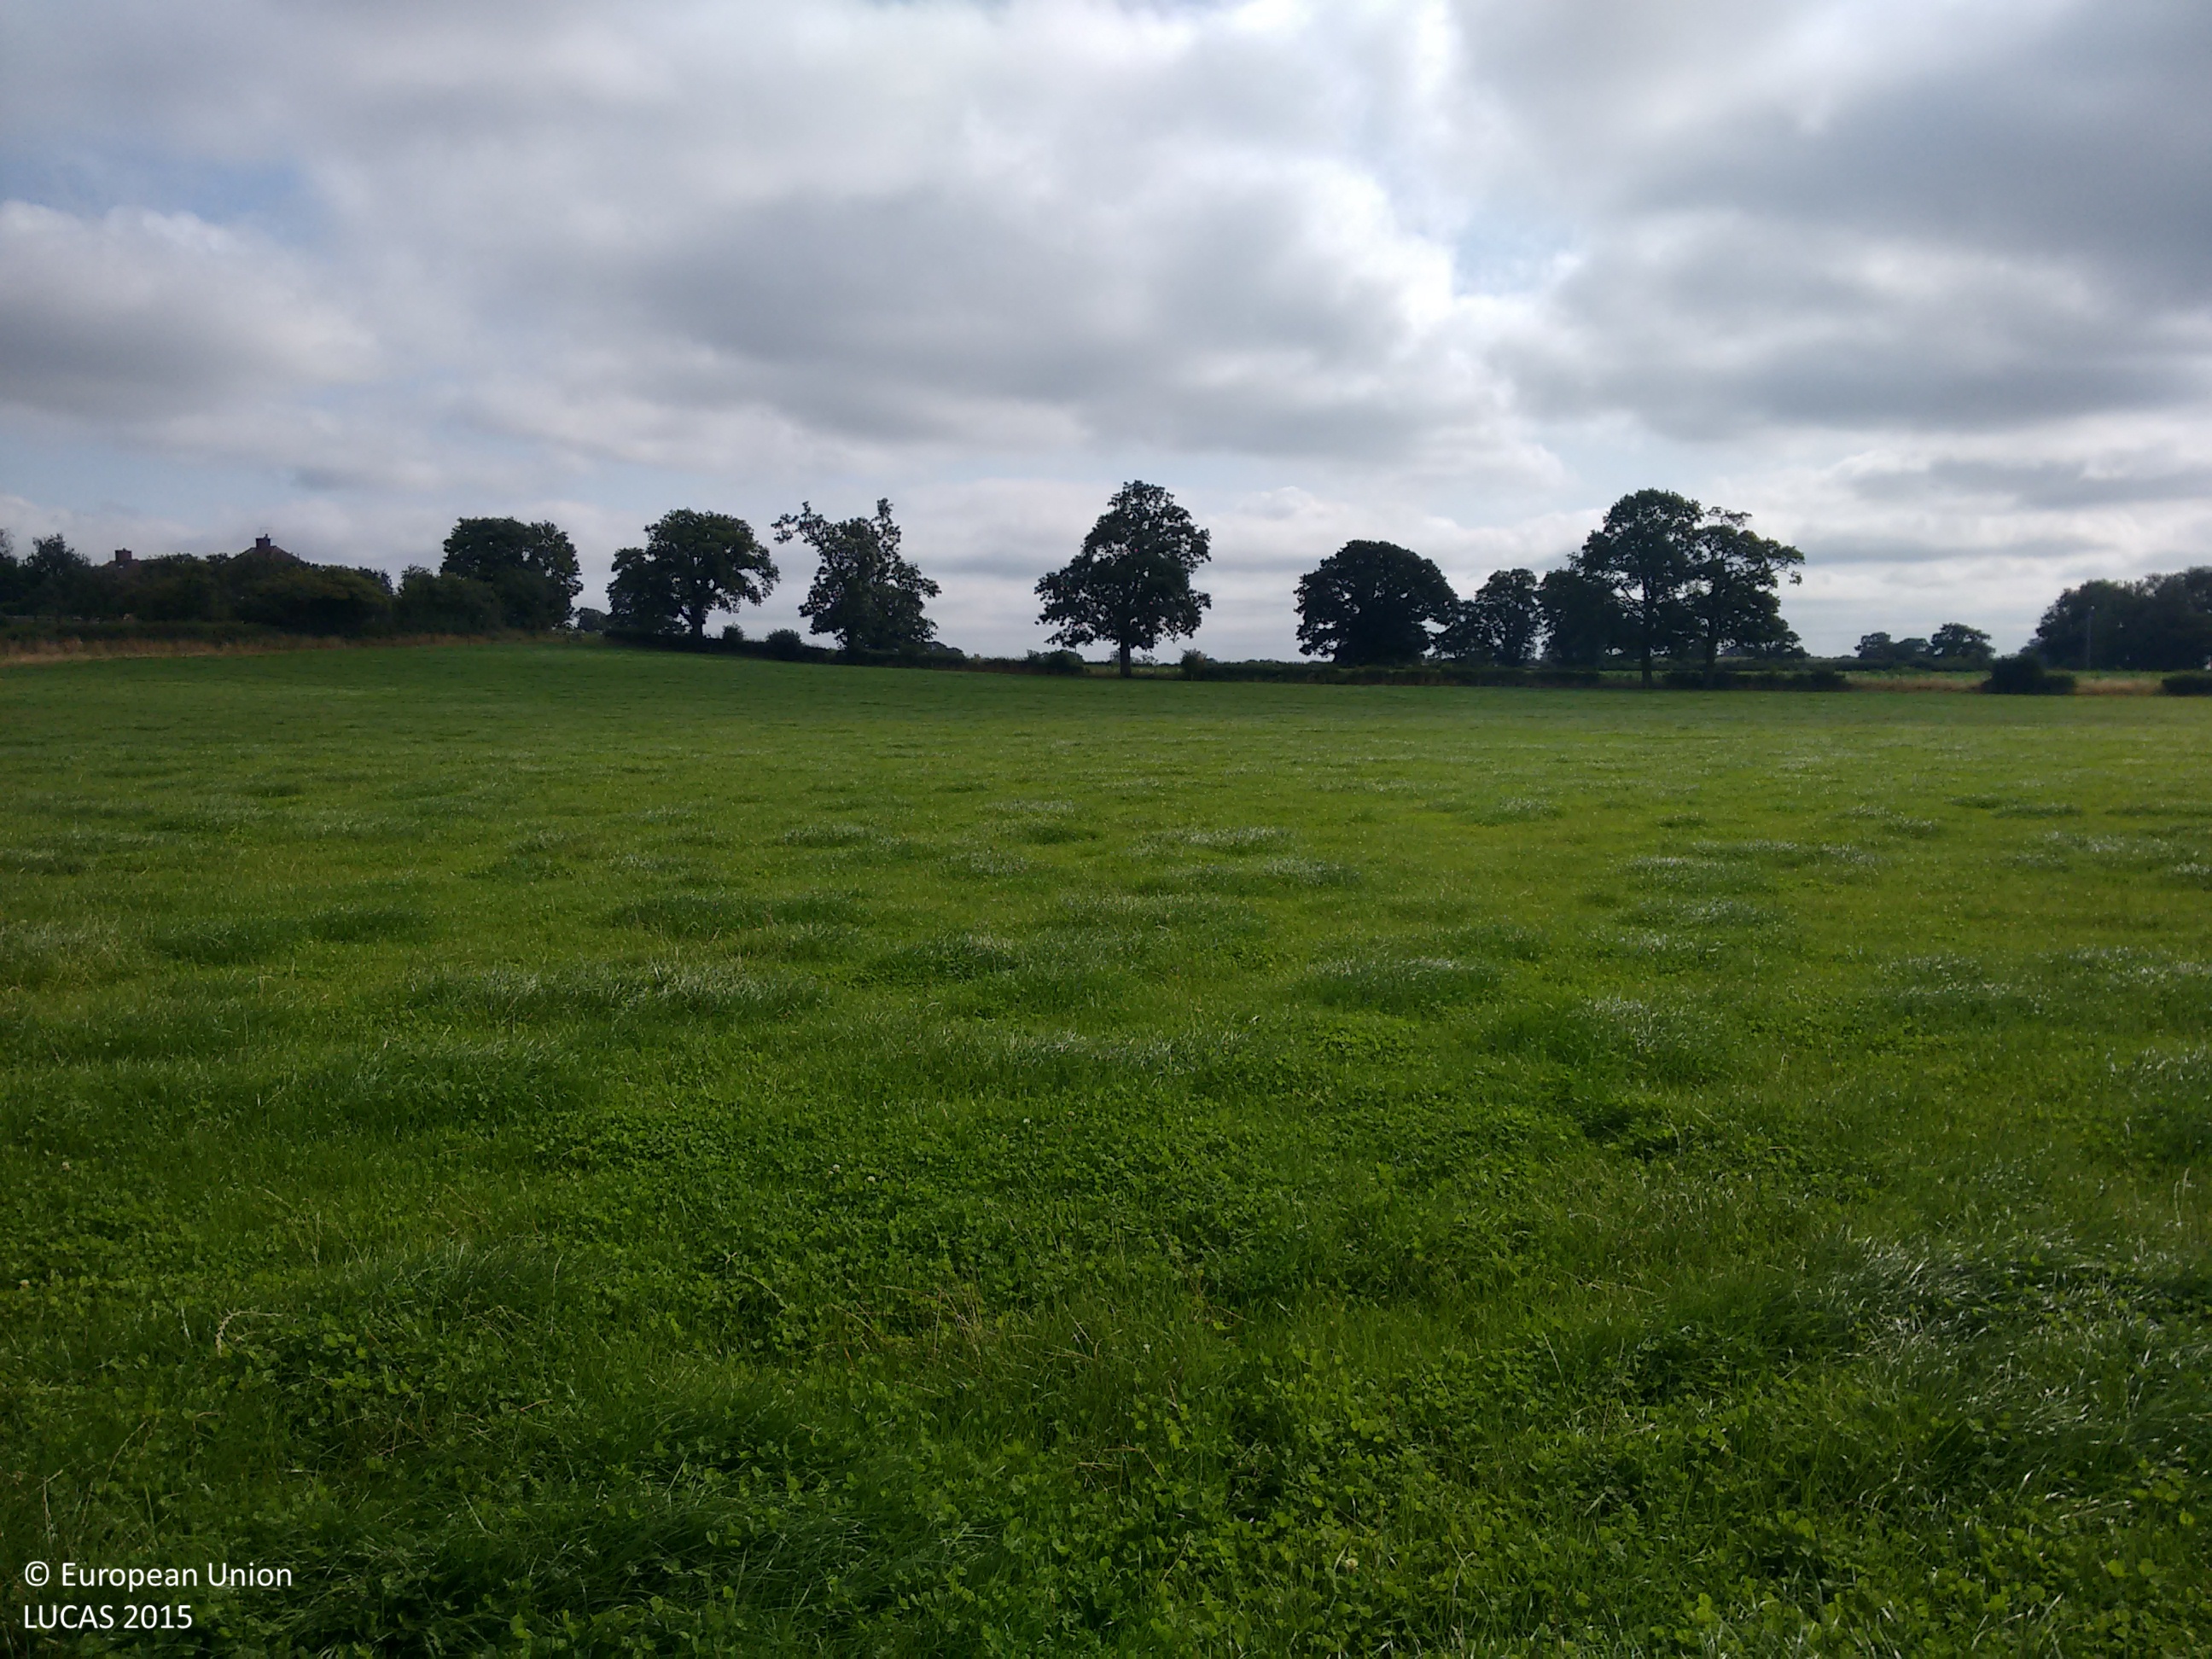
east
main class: Grassland
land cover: Grassland without tree/shrub cover
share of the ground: > 75 %
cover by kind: herbaceous plants 100 %
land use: Agriculture (excluding fallow land and kitchen gardens)
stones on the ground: < 10 %
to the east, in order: Grassland without tree/shrub cover; Fences; Grass margins; Managed hedges; Grass margins; Fences; Sugar beet
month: September
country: GB
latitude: 52.9395
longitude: -2.6116
